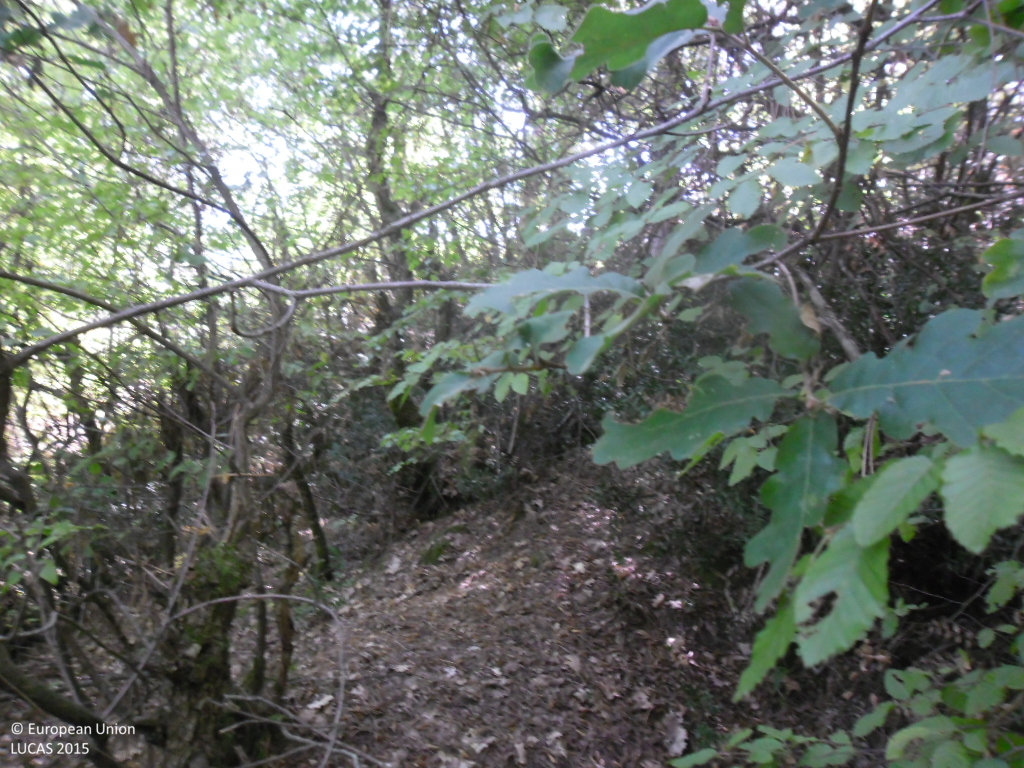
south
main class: Woodland
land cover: Other mixed woodland
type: hemiboreal forest and nemoral coniferous forest and mixed broadleaved-coniferous forest
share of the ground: > 75 %
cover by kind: coniferous forest trees 75 %, broadleaved forest trees 25 %
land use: Forestry
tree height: > 5 m
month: September
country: BG
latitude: 41.7422
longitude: 23.1162
